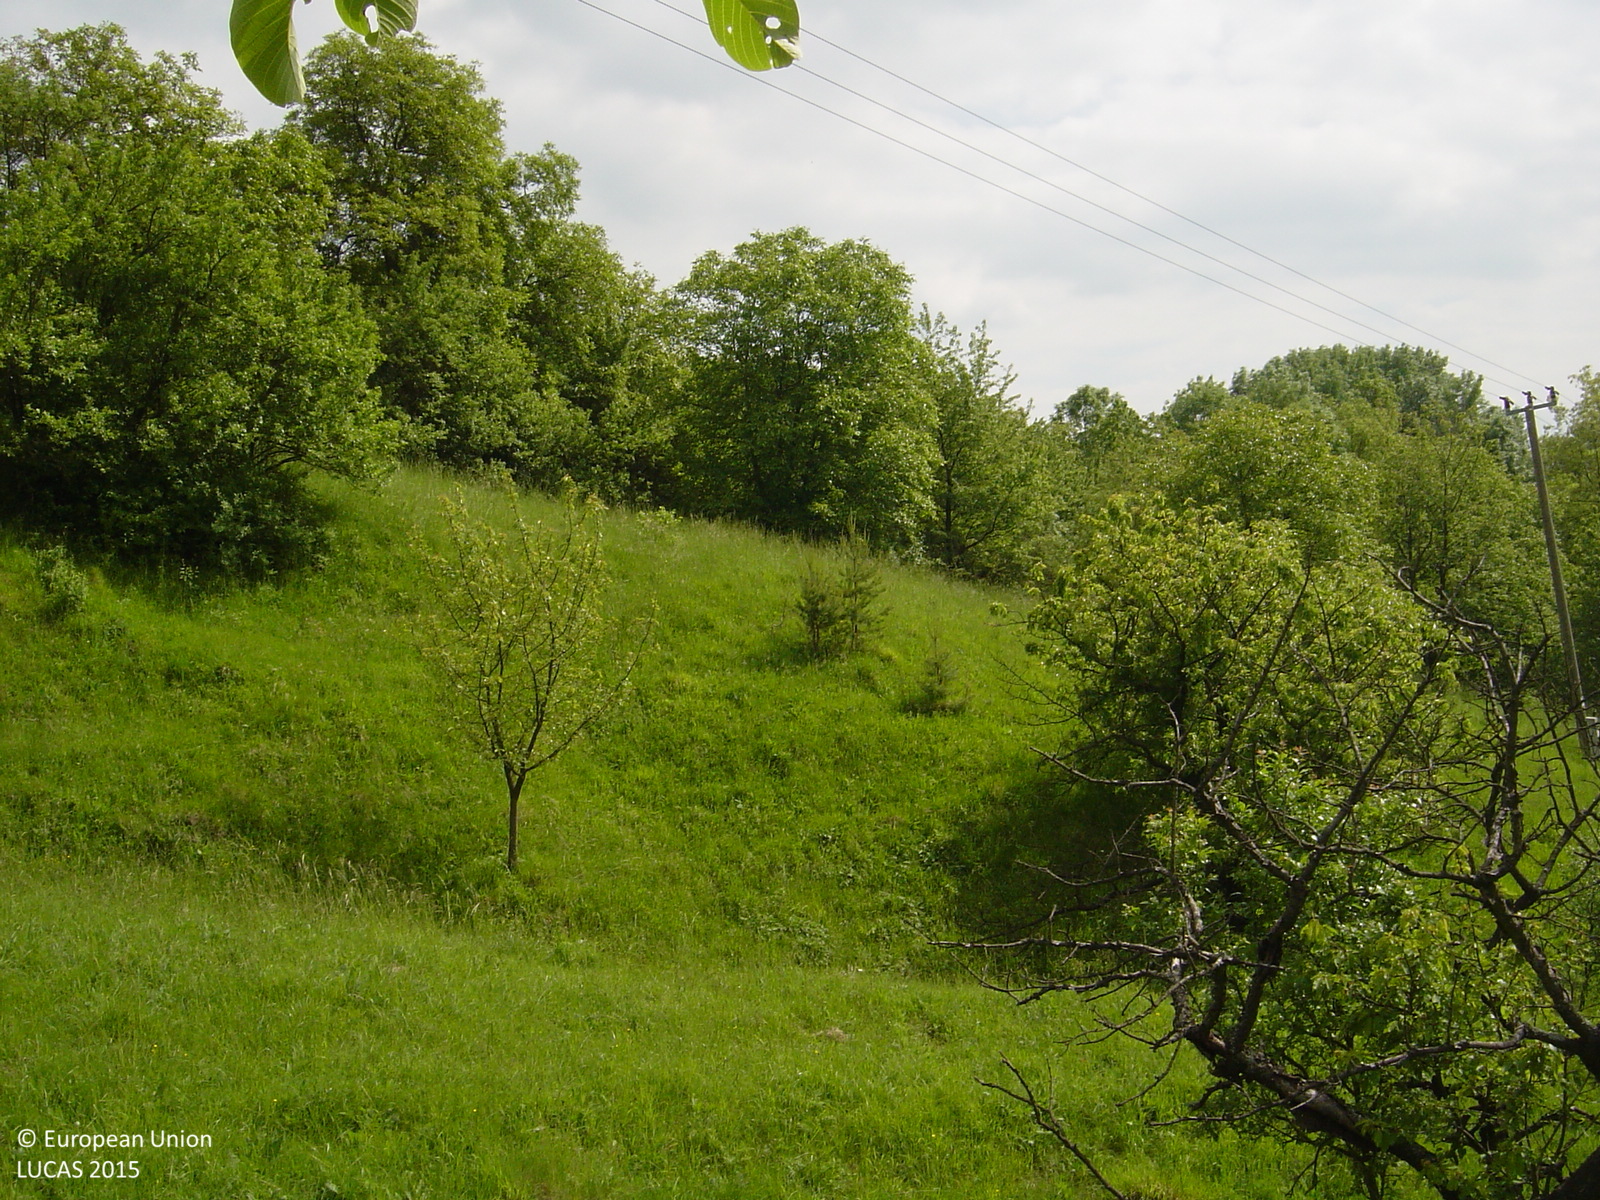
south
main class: Cropland
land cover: Cherry fruit
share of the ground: < 10 %
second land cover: Grassland without tree/shrub cover
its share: > 75 %
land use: Kitchen garden
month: May
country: CZ
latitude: 49.0628
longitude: 17.0576
